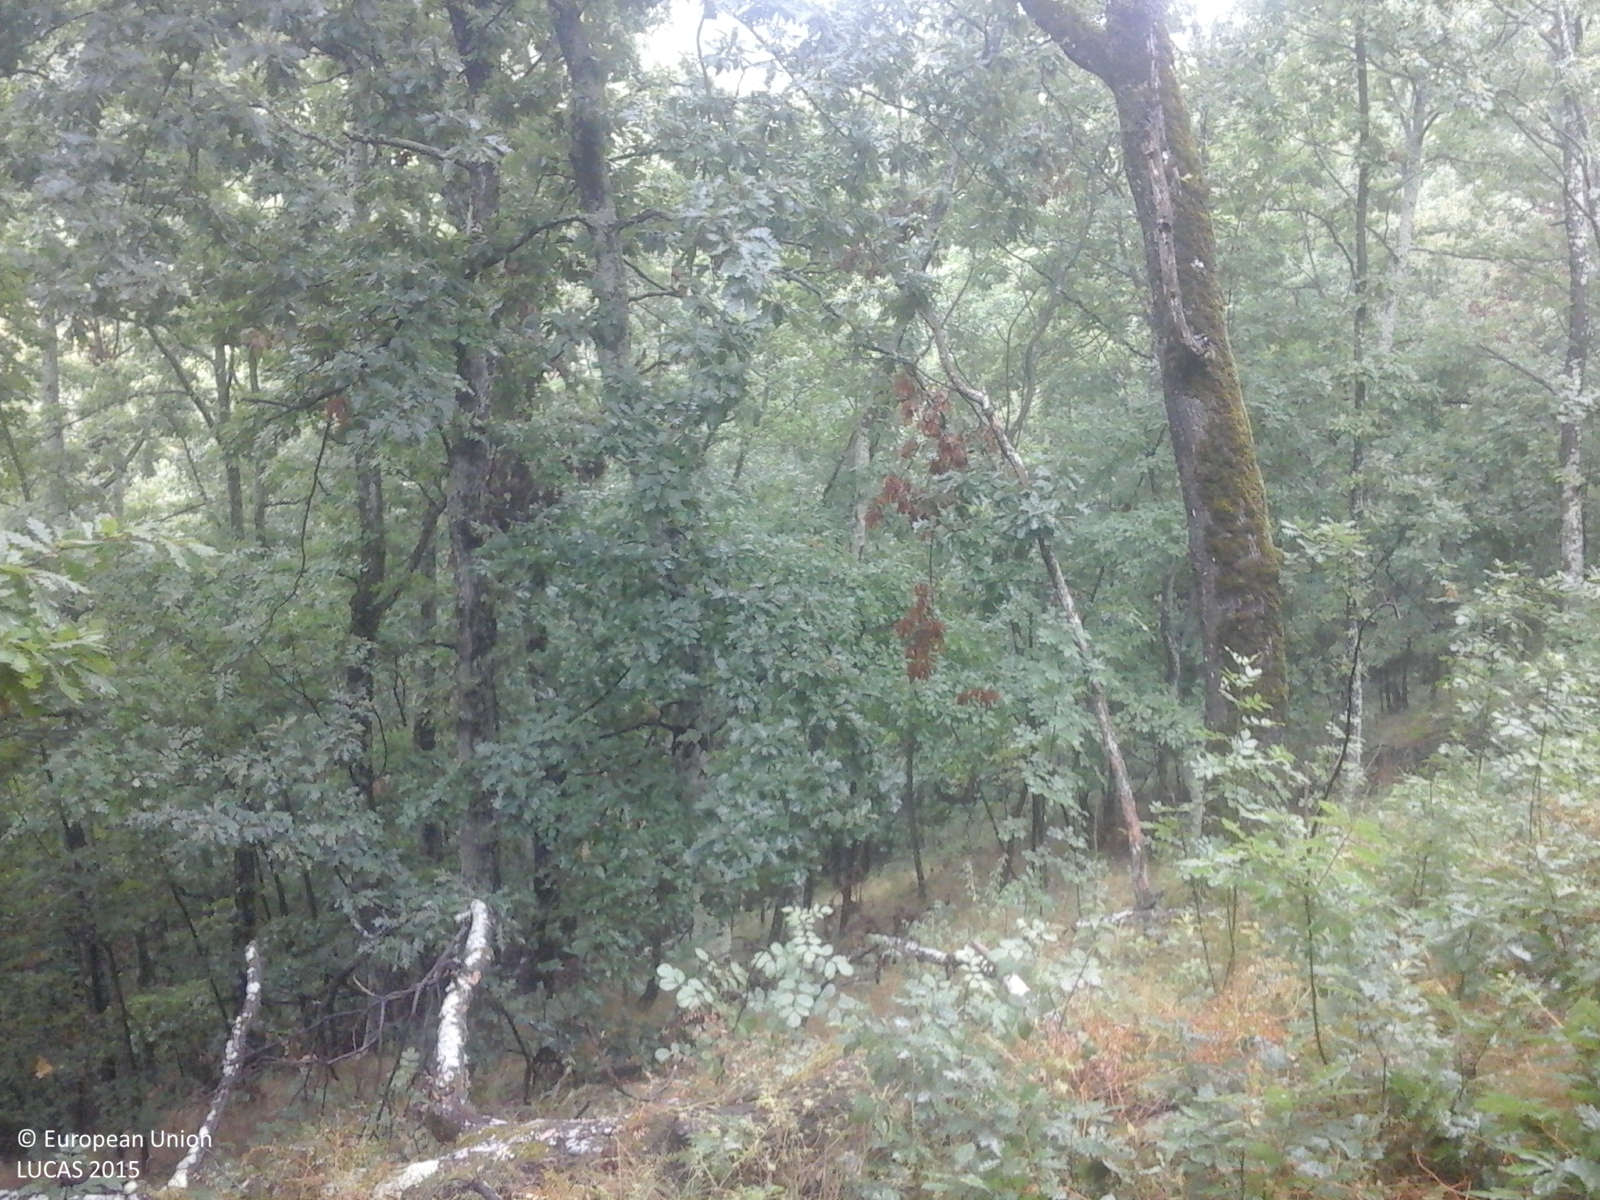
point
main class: Woodland
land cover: Broadleaved woodland
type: thermophilous deciduous forest
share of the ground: > 75 %
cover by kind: broadleaved forest trees 95 %, herbaceous plants 5 %
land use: Forestry
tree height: > 5 m
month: August
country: RO
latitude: 45.0088
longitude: 22.2313
